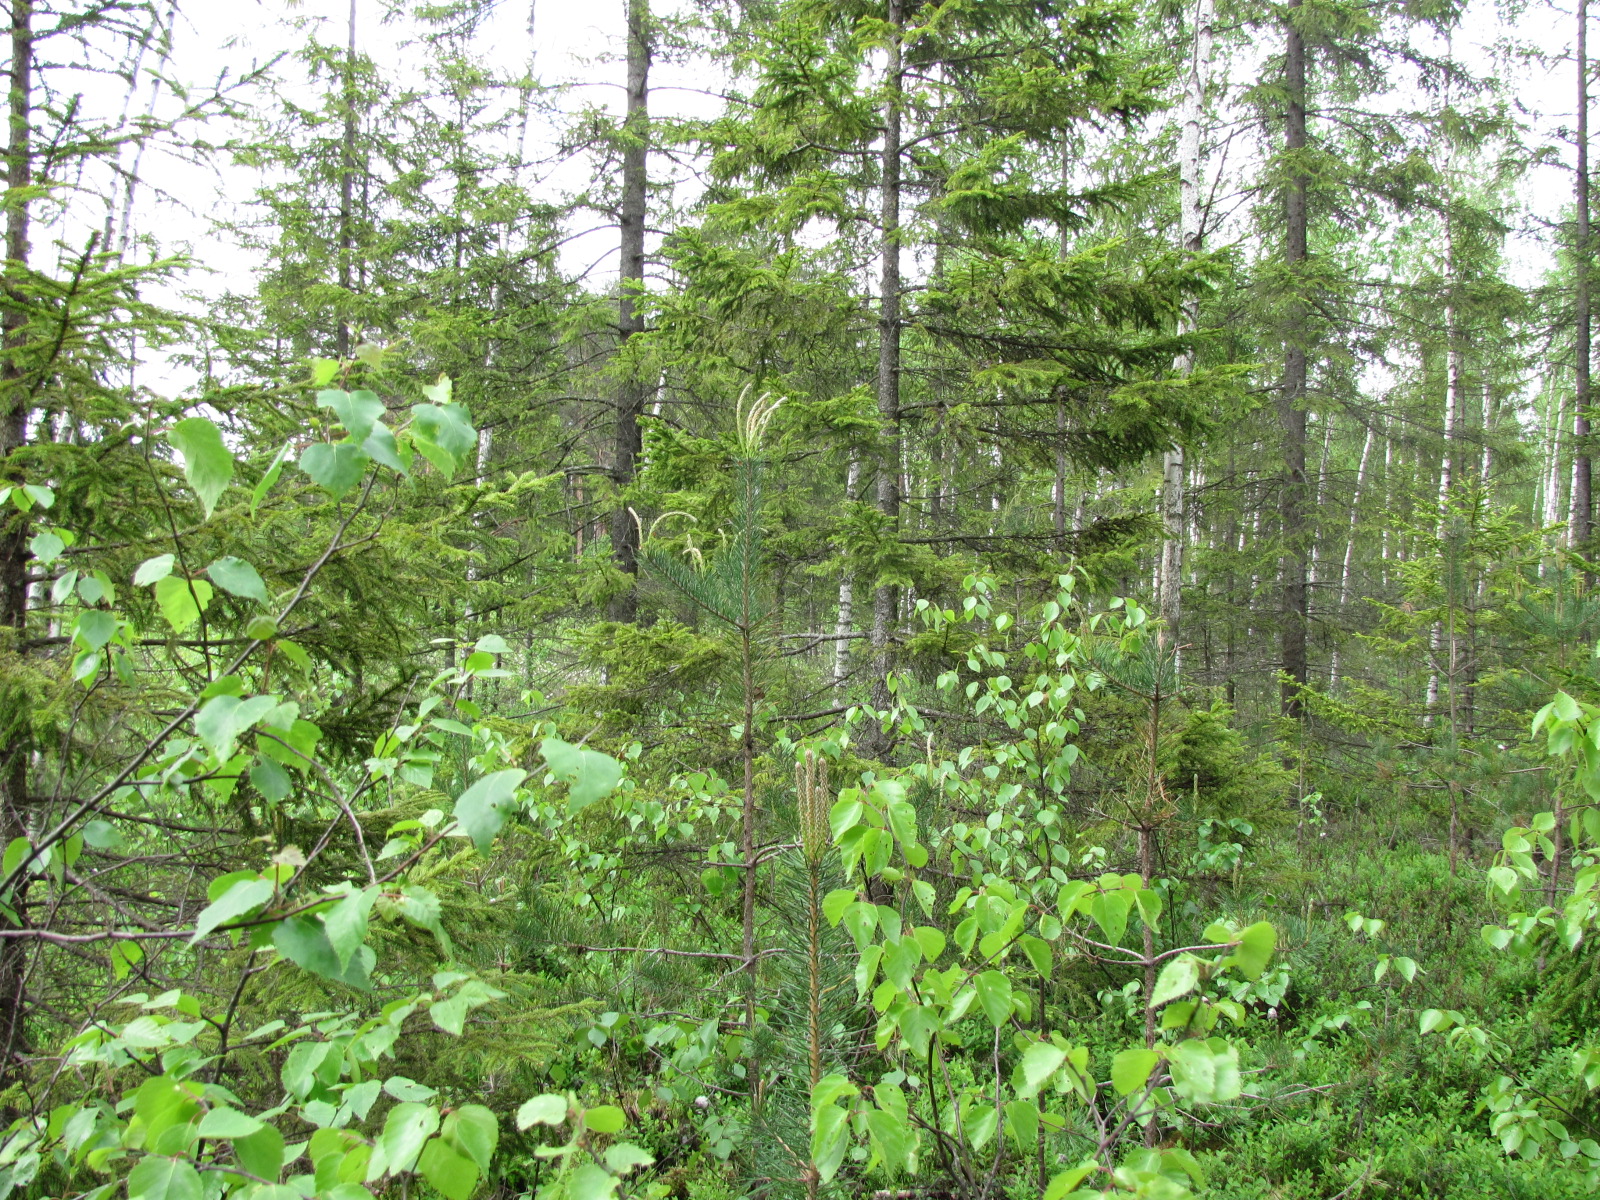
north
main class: Woodland
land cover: Spruce dominated mixed woodland
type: hemiboreal forest and nemoral coniferous forest and mixed broadleaved-coniferous forest
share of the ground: 50 - 75 %
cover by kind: coniferous forest trees 30 %, broadleaved forest trees 30 %, herbaceous plants 20 %, lichens and mosses 20 %
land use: Forestry
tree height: > 5 m
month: June
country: LV
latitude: 56.6442
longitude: 24.2944
